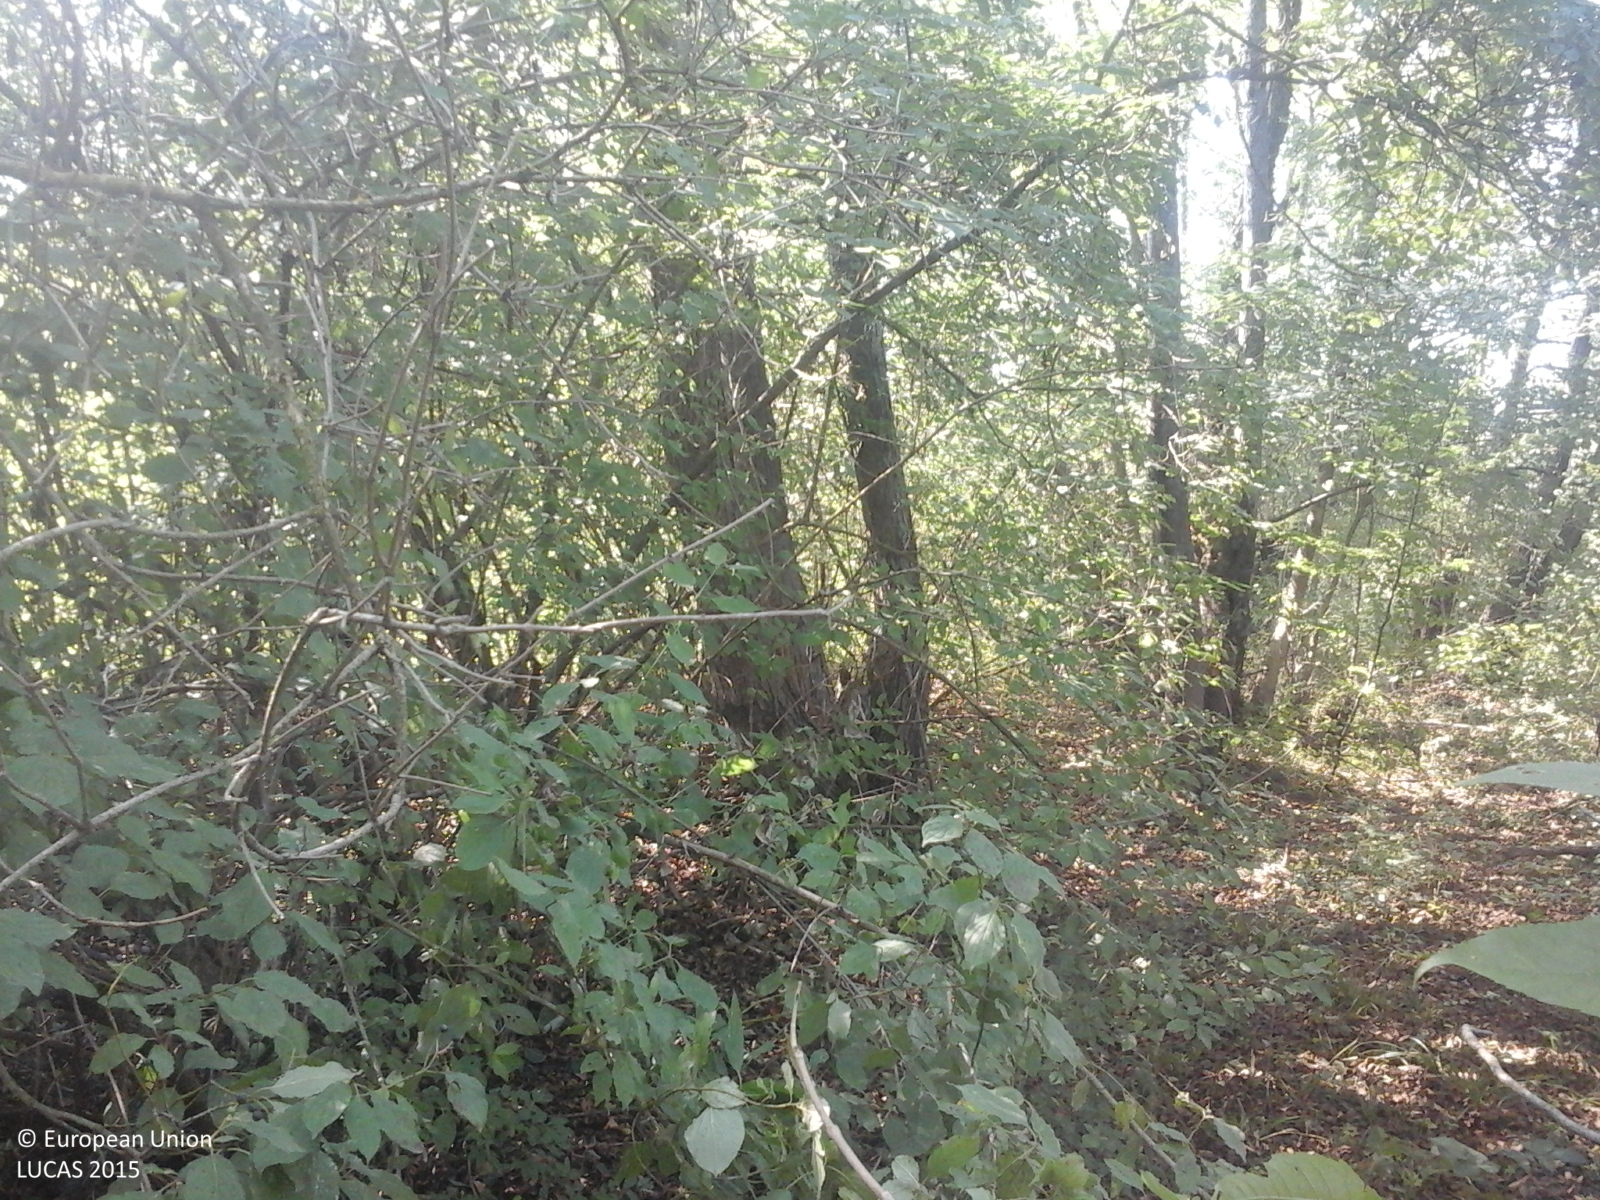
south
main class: Woodland
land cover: Broadleaved woodland
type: non-riverine alder, birch or aspen forest
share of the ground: > 75 %
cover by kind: broadleaved forest trees 100 %
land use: Forestry
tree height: > 5 m
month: August
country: RO
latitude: 46.4311
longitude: 22.2148
